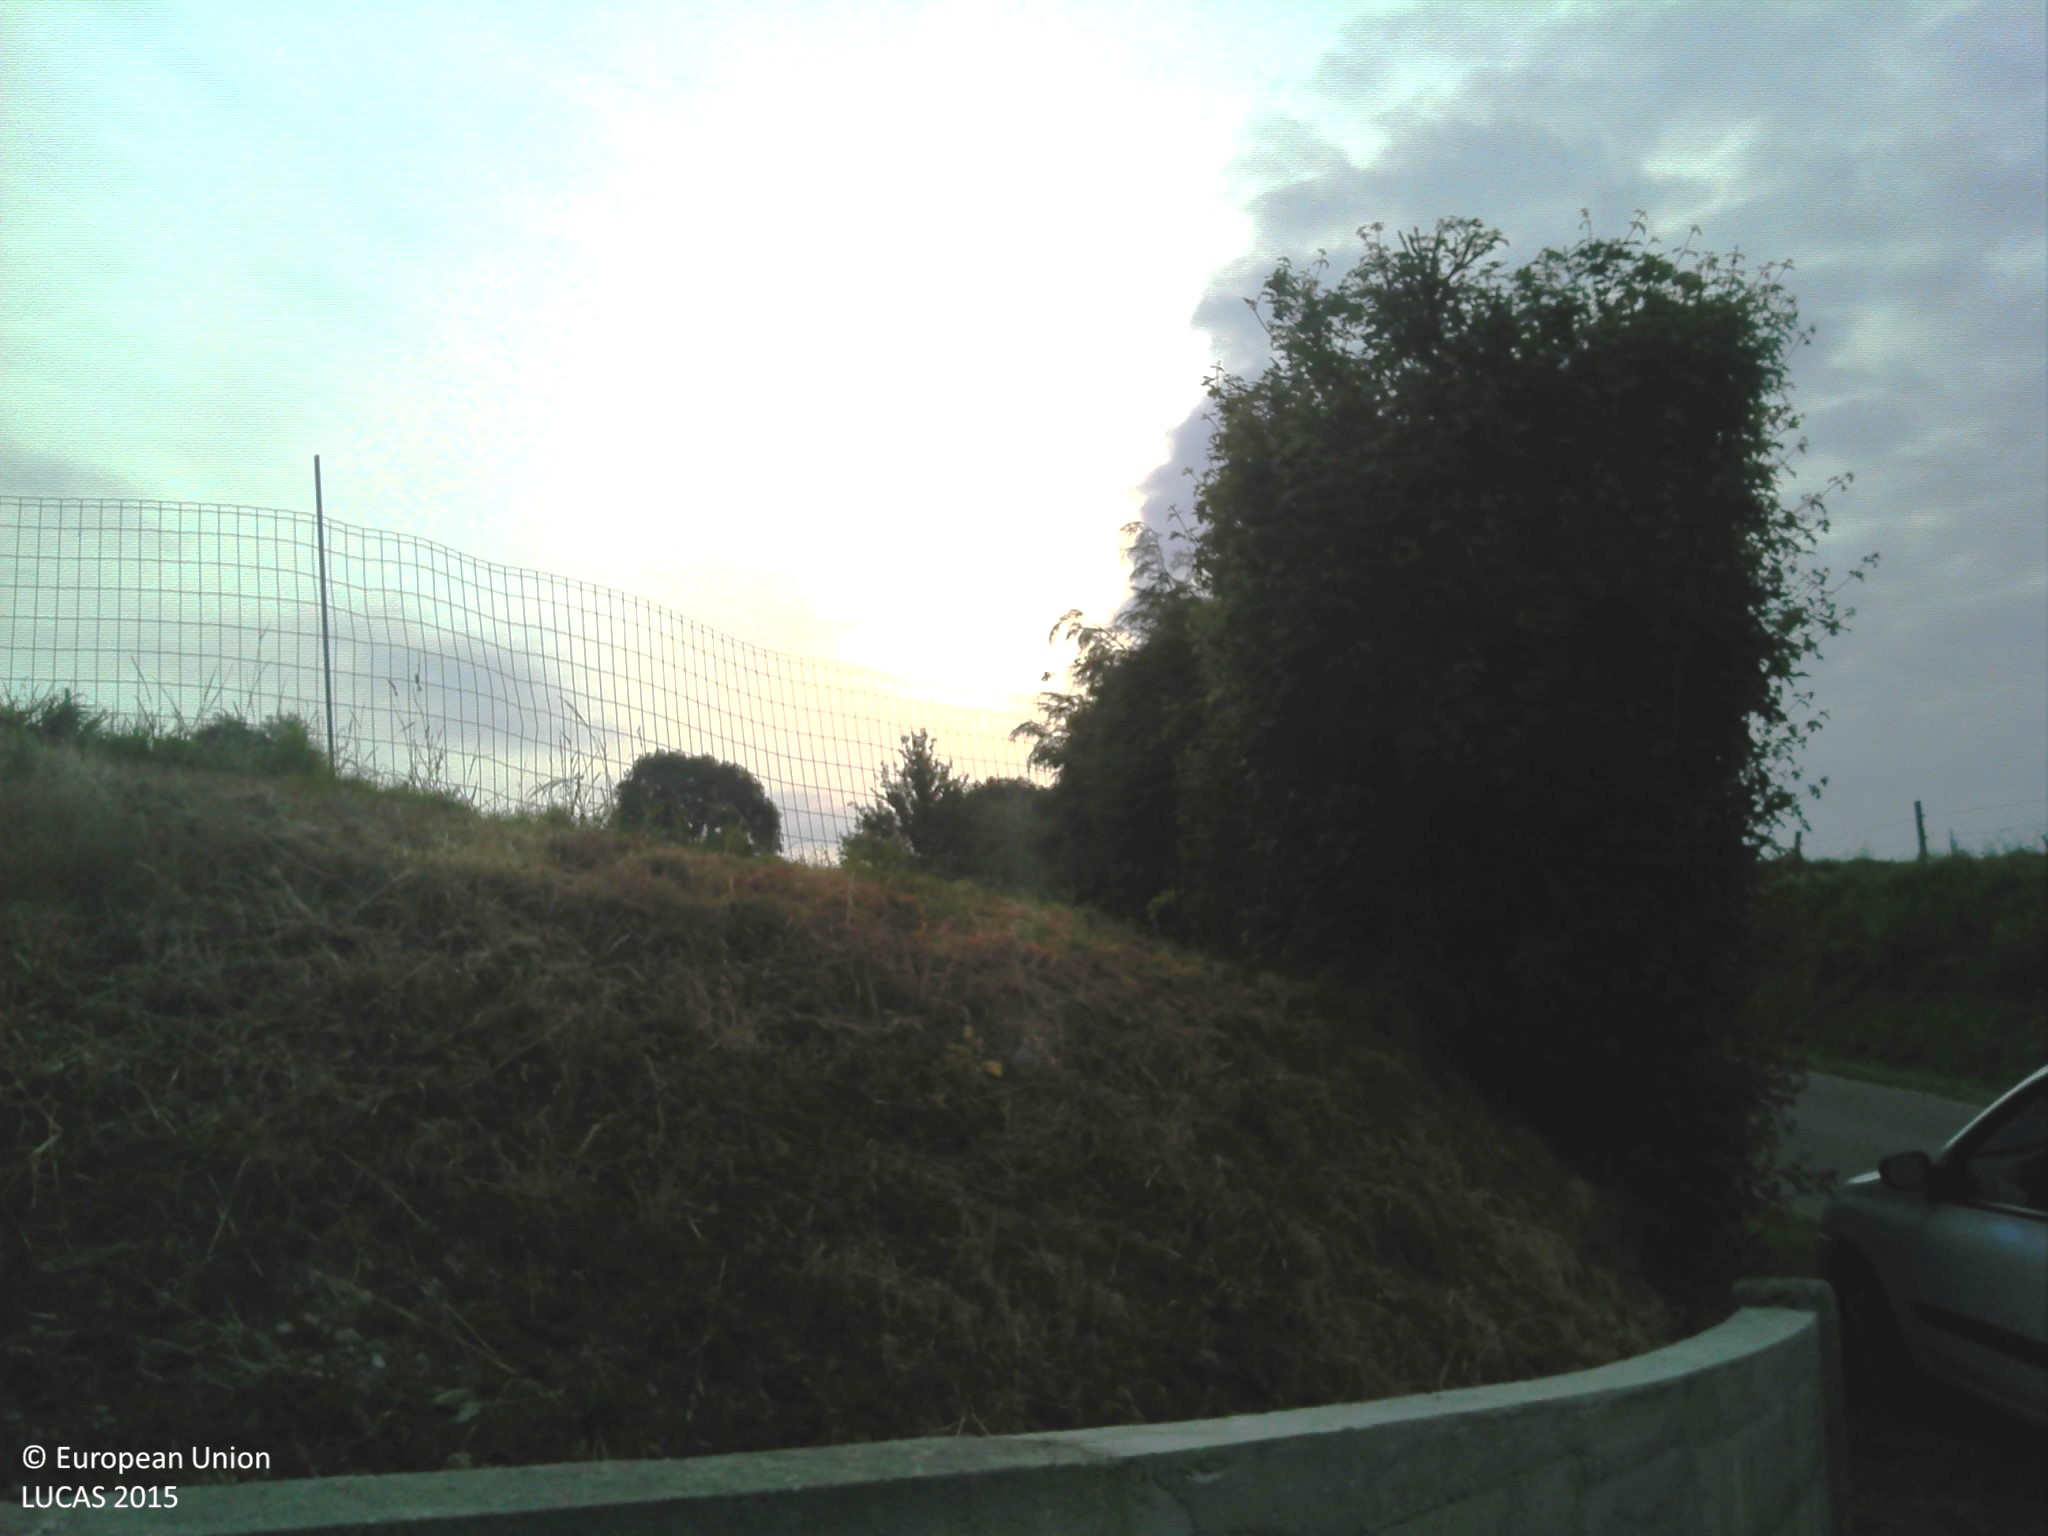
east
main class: Woodland
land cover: Broadleaved woodland
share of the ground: > 75 %
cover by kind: broadleaved forest trees 70 %, herbaceous plants 30 %
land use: Semi-natural and natural areas not in use
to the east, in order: Broadleaved woodland; Grassland without tree/shrub cover; Single bushes/trees; Grassland with sparse tree/shrub cover; Single bushes/trees; Tracks; Grassland without tree/shrub cover; Fences; Rape and turnip rape; Grass margins; Fences; Single bushes/trees; Grass margins; Maize
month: June
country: FR
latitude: 48.2515
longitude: -0.0631
